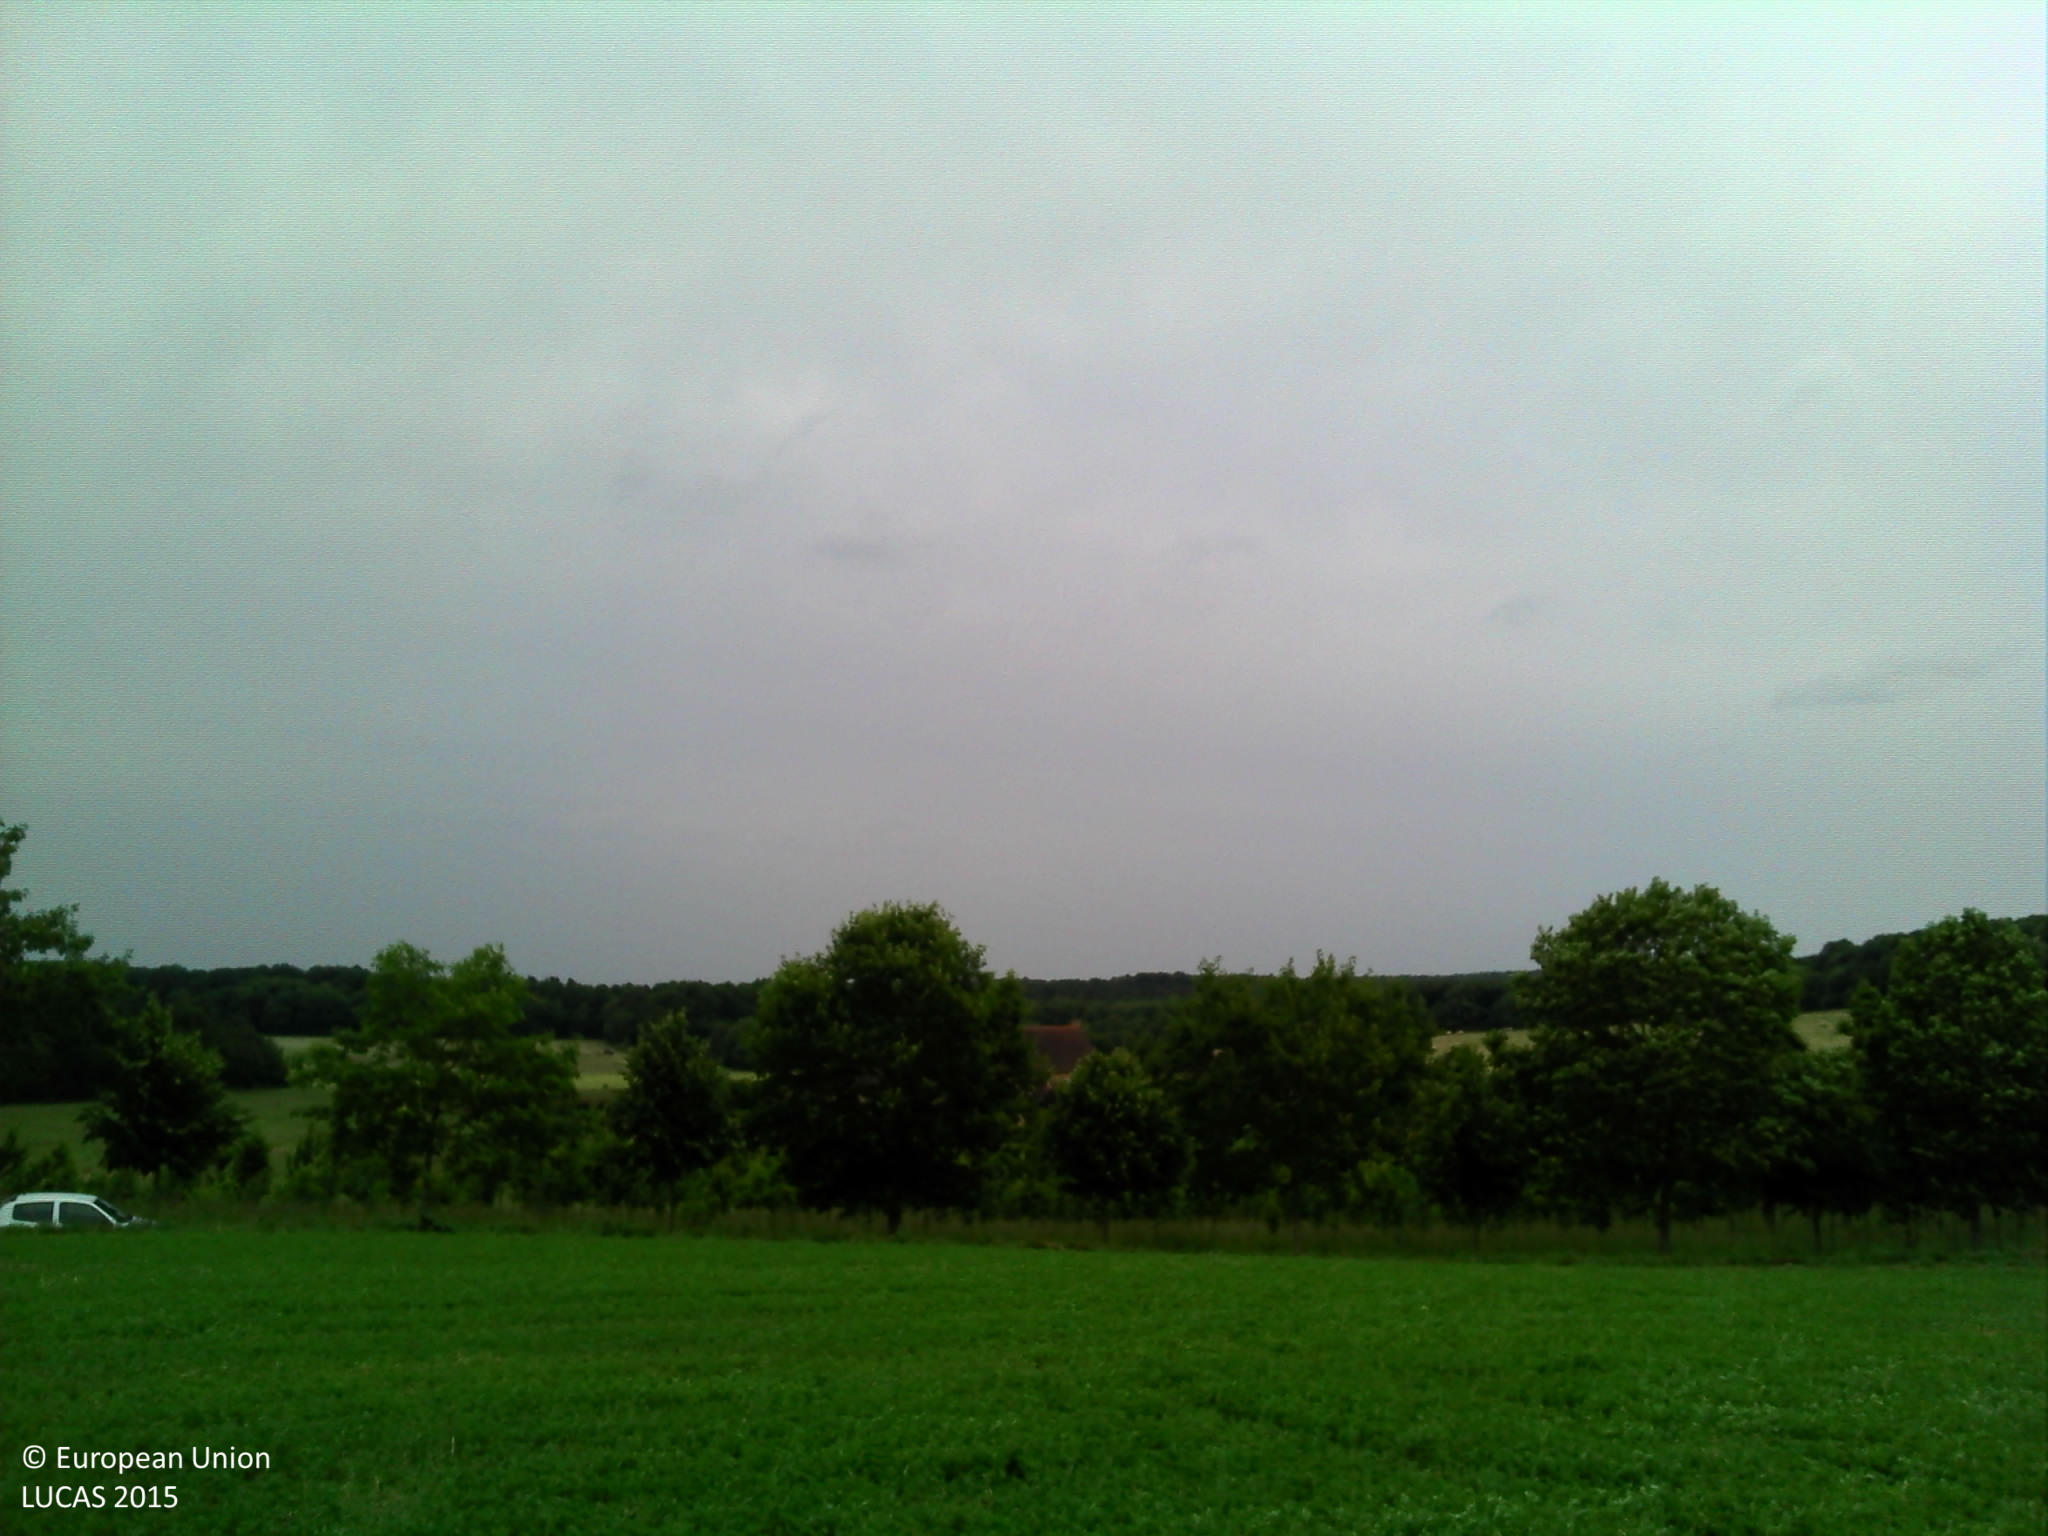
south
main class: Cropland
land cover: Other leguminous and mixtures for fodder
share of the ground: > 75 %
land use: Agriculture (excluding fallow land and kitchen gardens)
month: June
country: FR
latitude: 48.2361
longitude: -0.0329
